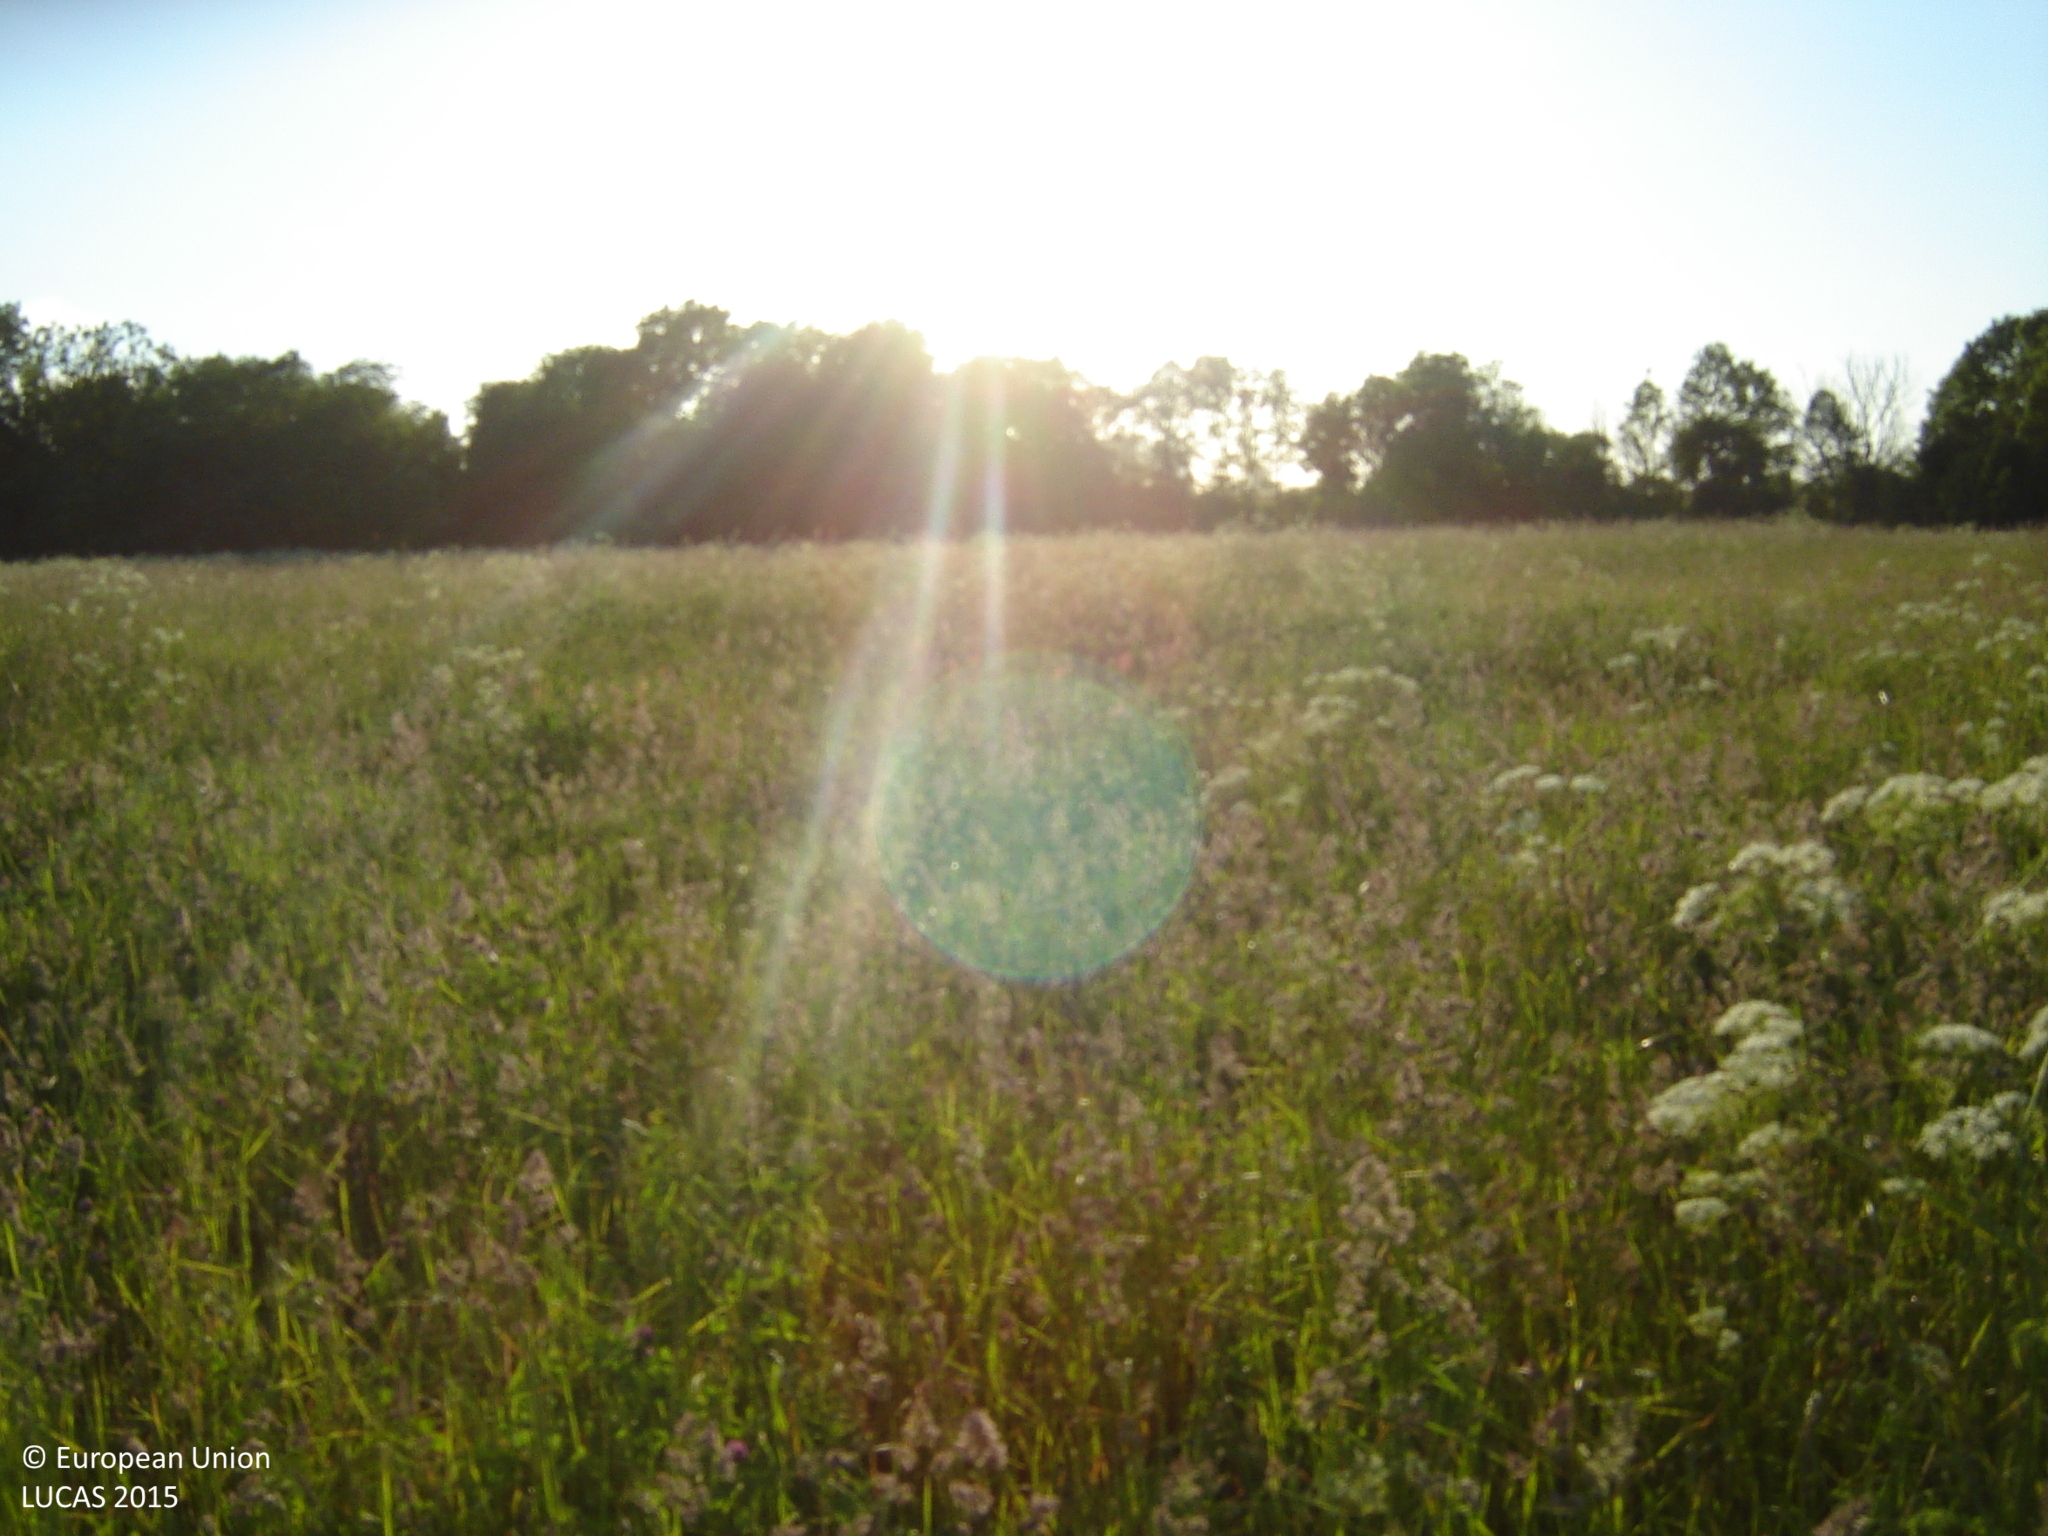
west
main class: Grassland
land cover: Grassland without tree/shrub cover
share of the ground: > 75 %
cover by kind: herbaceous plants 100 %
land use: Agriculture (excluding fallow land and kitchen gardens)
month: June
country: LT
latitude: 55.5468
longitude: 25.2217
